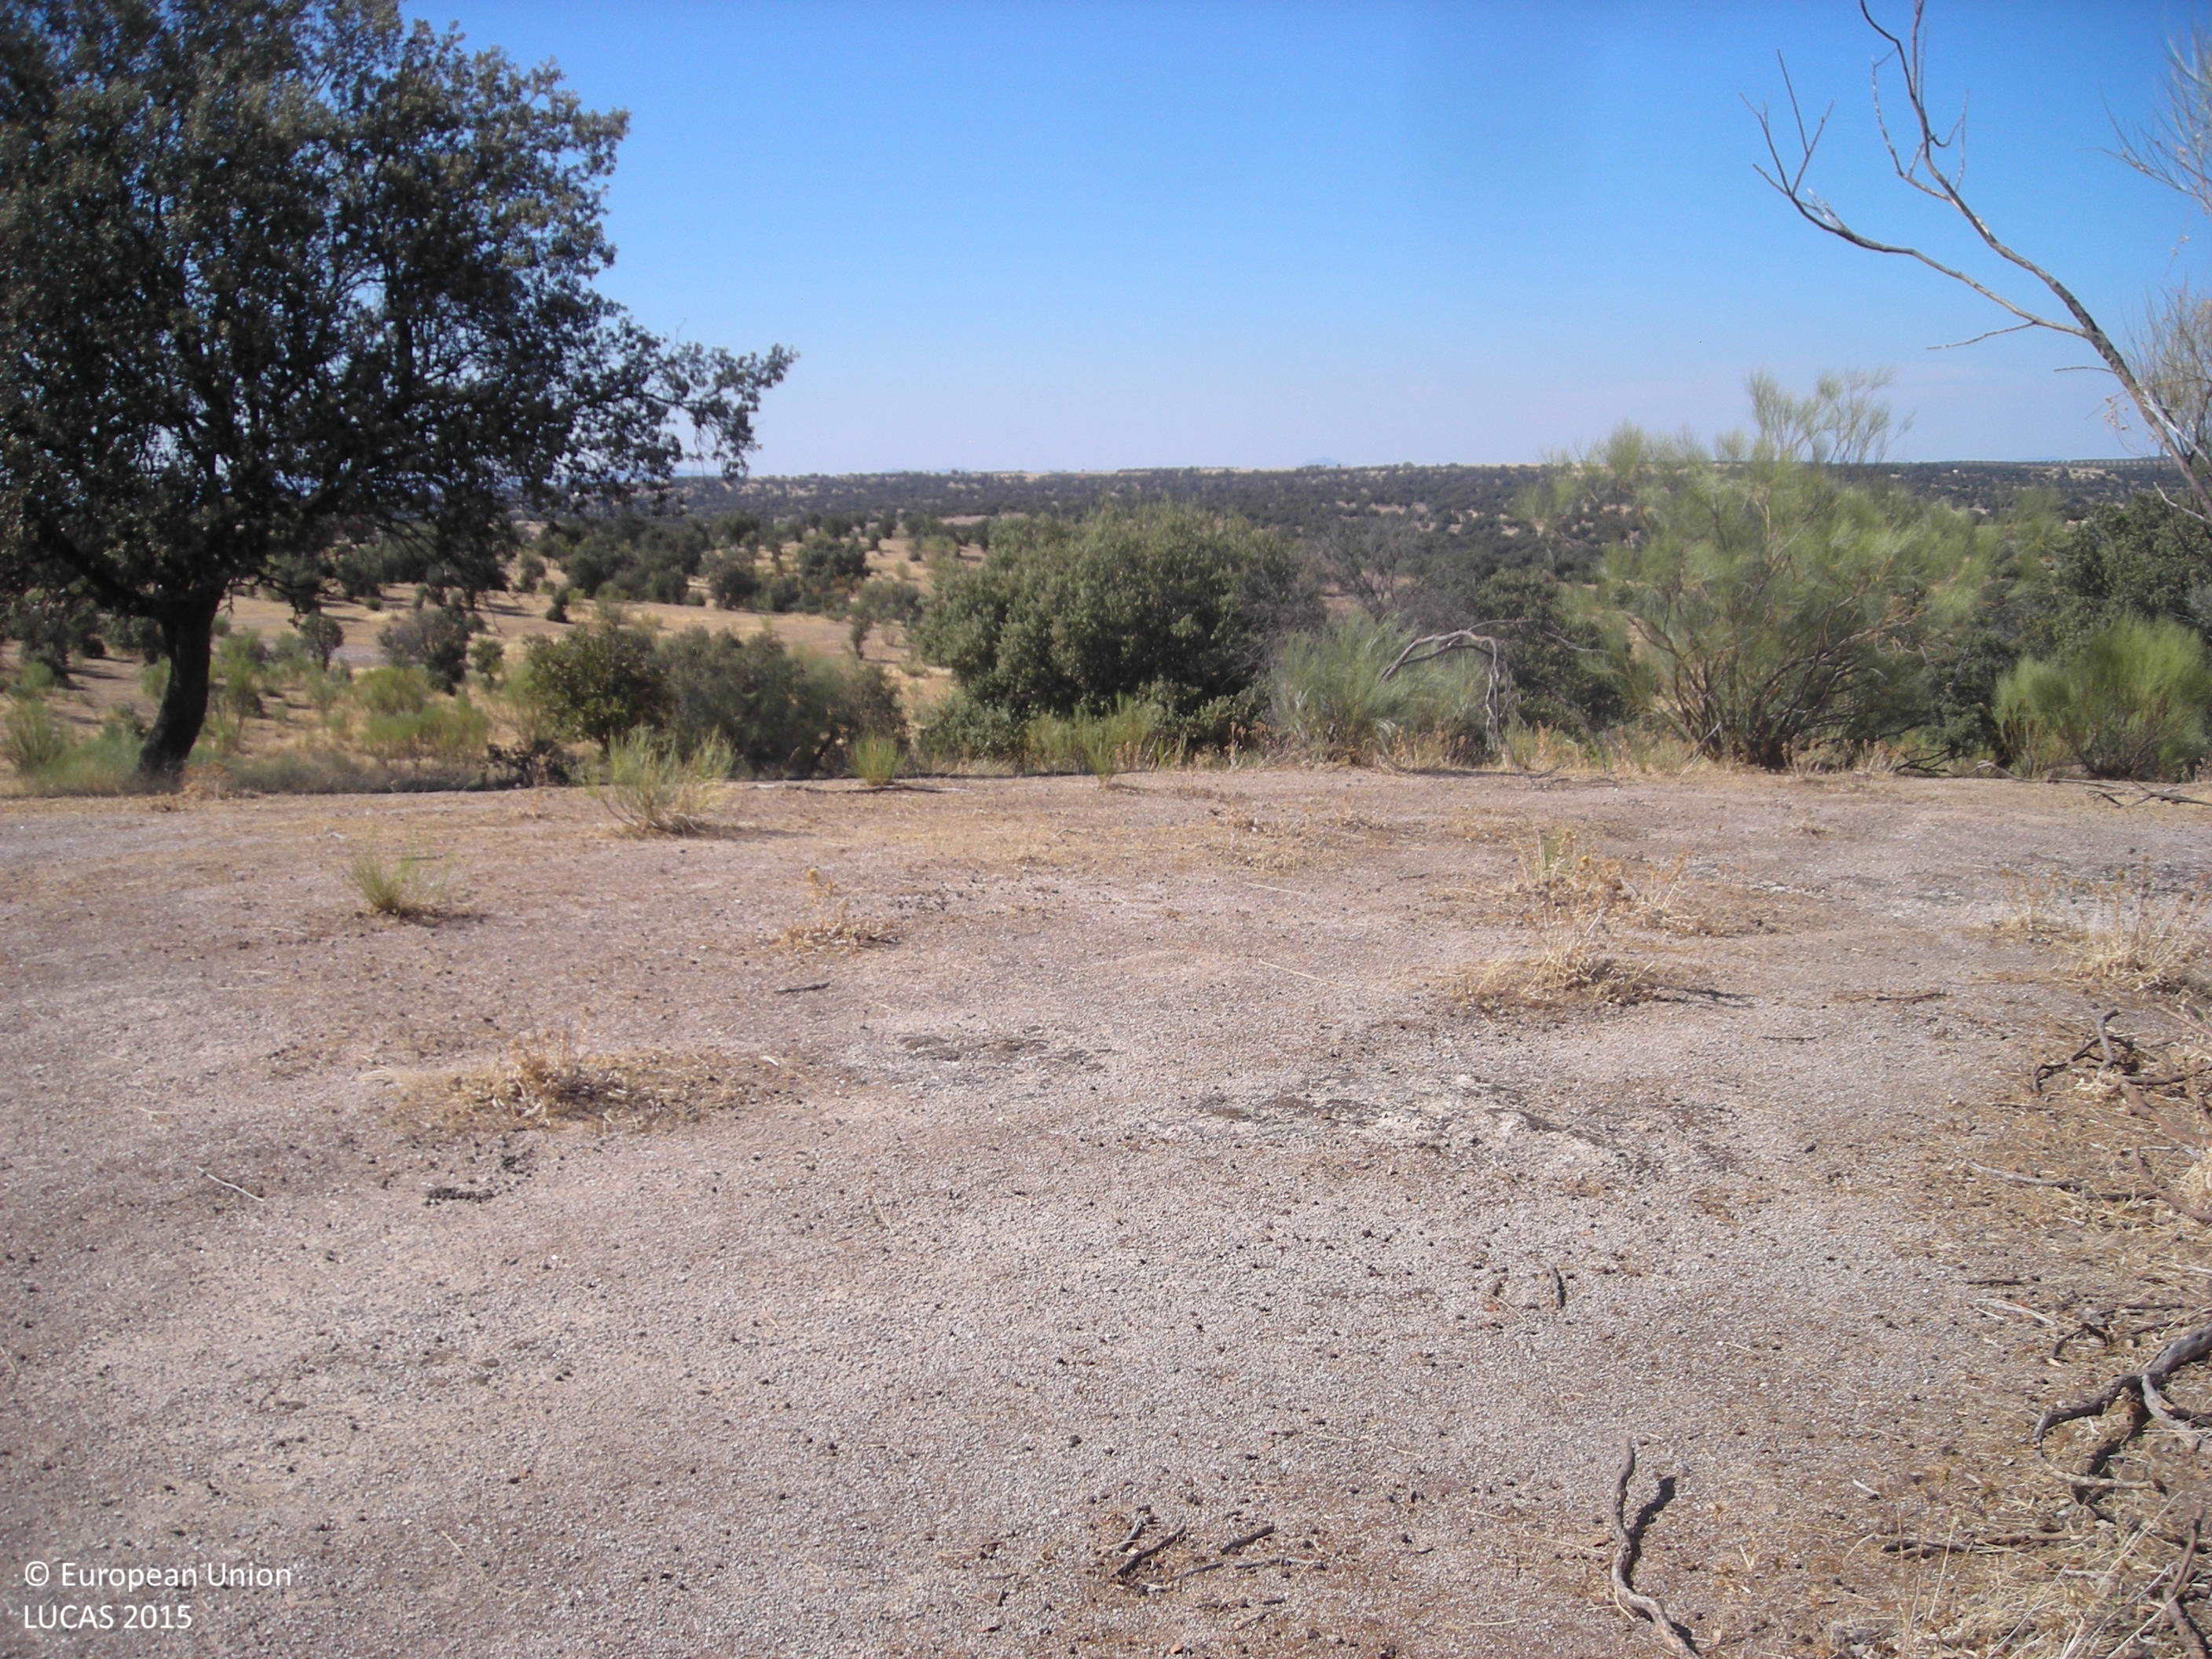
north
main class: Shrubland
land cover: Shrubland with sparse tree cover
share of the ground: > 75 %
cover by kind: shrubs 95 %, broadleaved forest trees 5 %
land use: Agriculture (excluding fallow land and kitchen gardens)
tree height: > 5 m
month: July
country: ES
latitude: 38.8496
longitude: -5.7974
